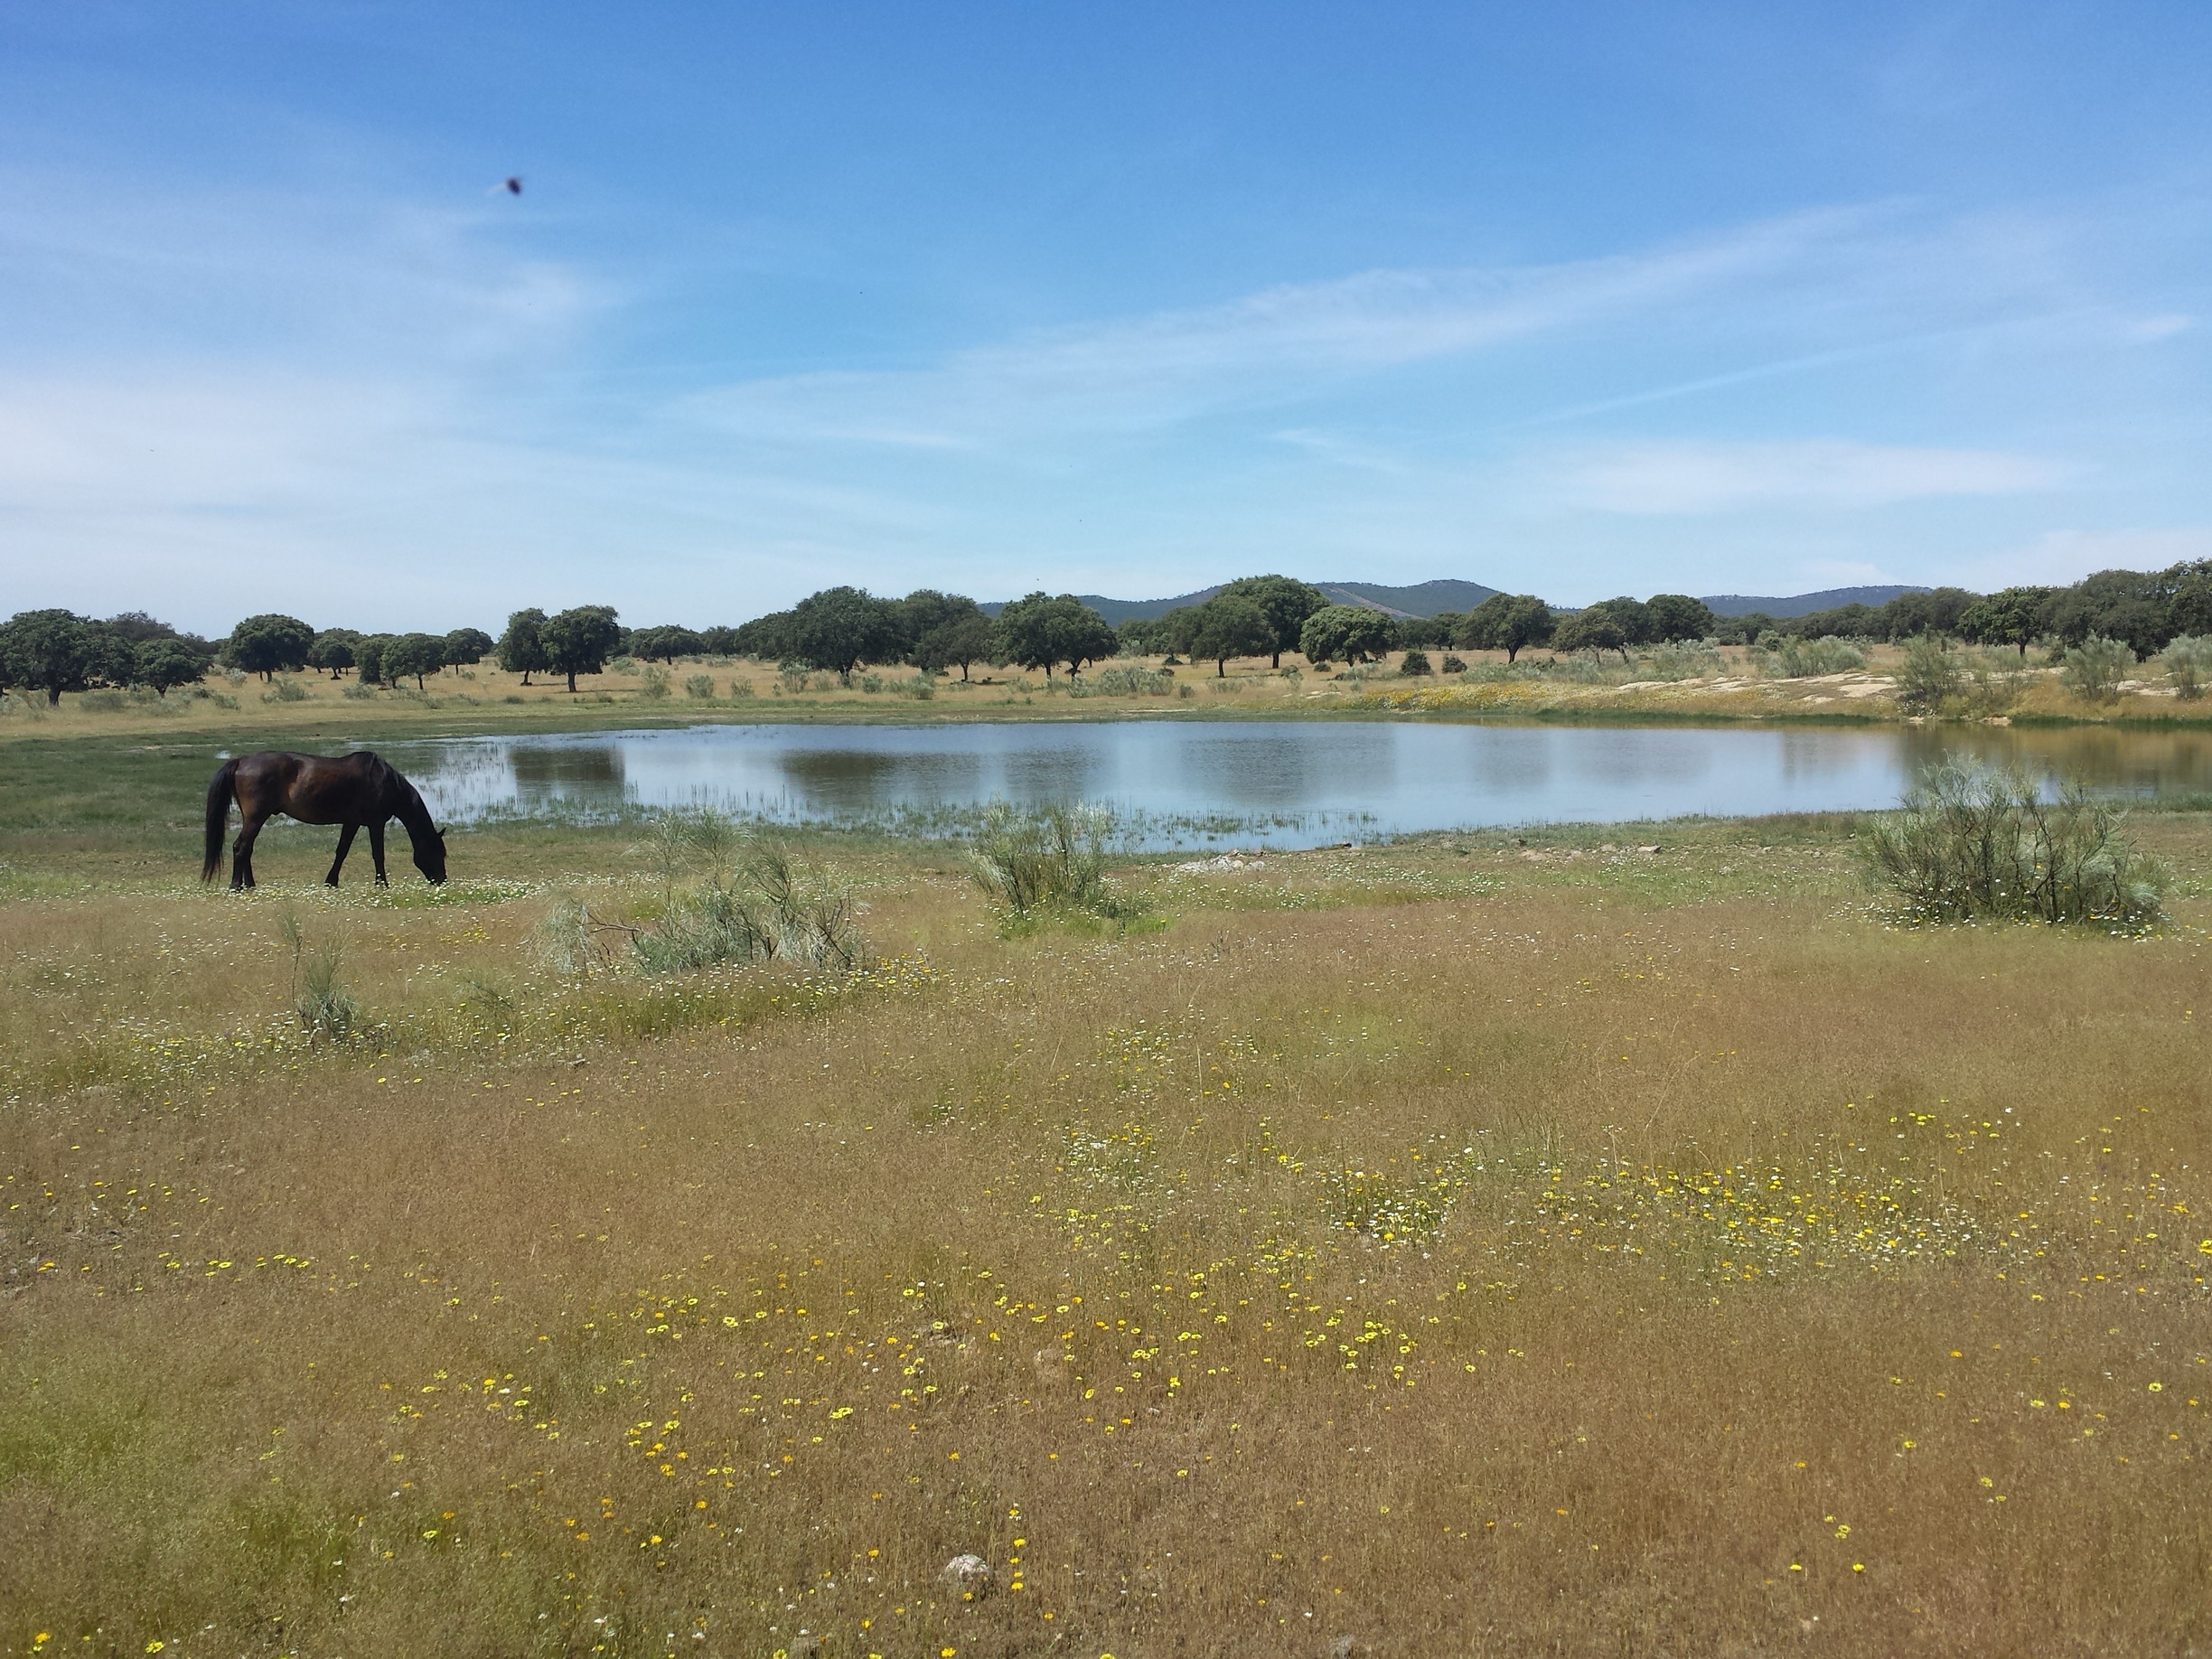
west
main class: Woodland
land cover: Broadleaved woodland
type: broadleaved evergreen forest
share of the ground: 10 - 25 %
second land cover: Grassland without tree/shrub cover
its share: > 75 %
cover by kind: herbaceous plants 85 %, broadleaved forest trees 15 %
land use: Forestry
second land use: Agriculture (excluding fallow land and kitchen gardens)
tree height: > 5 m
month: May
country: ES
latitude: 39.5667
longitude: -7.0911
